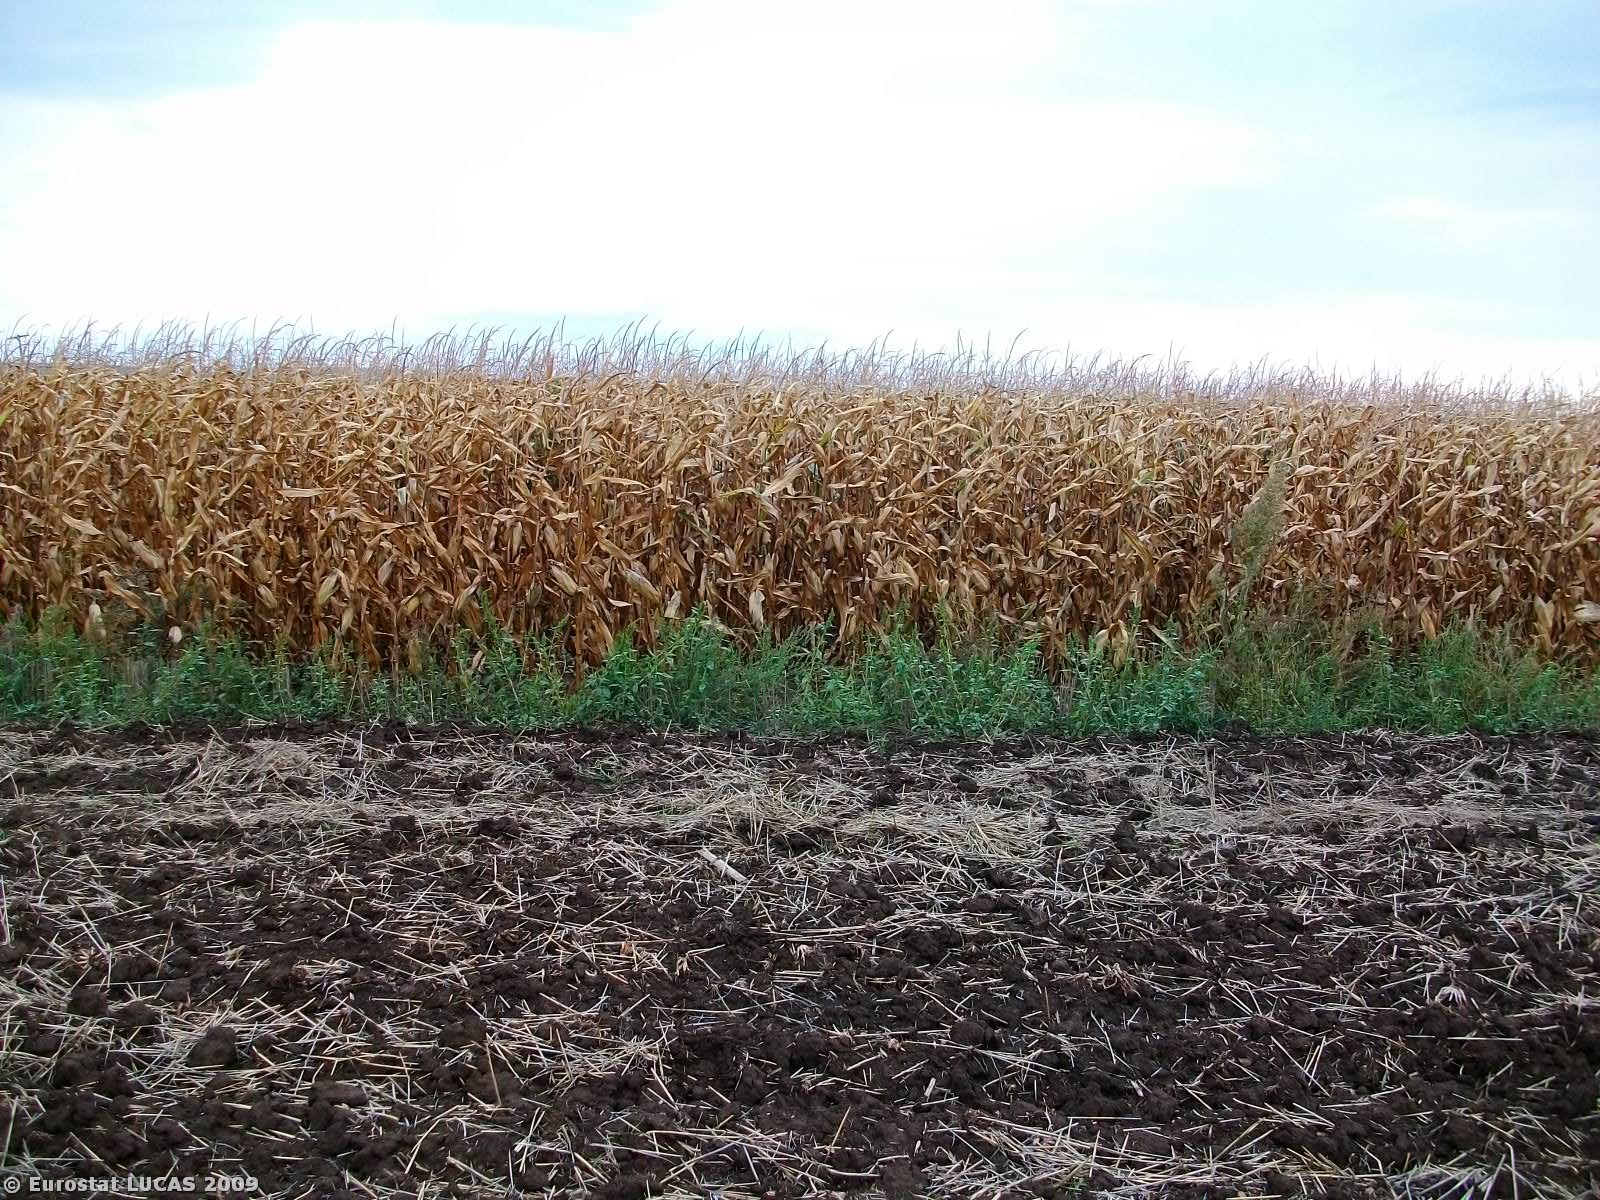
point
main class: Cropland
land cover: Maize
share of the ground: > 75 %
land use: Agriculture (excluding fallow land and kitchen gardens)
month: September
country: GR
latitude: 39.3564
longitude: 22.3451
